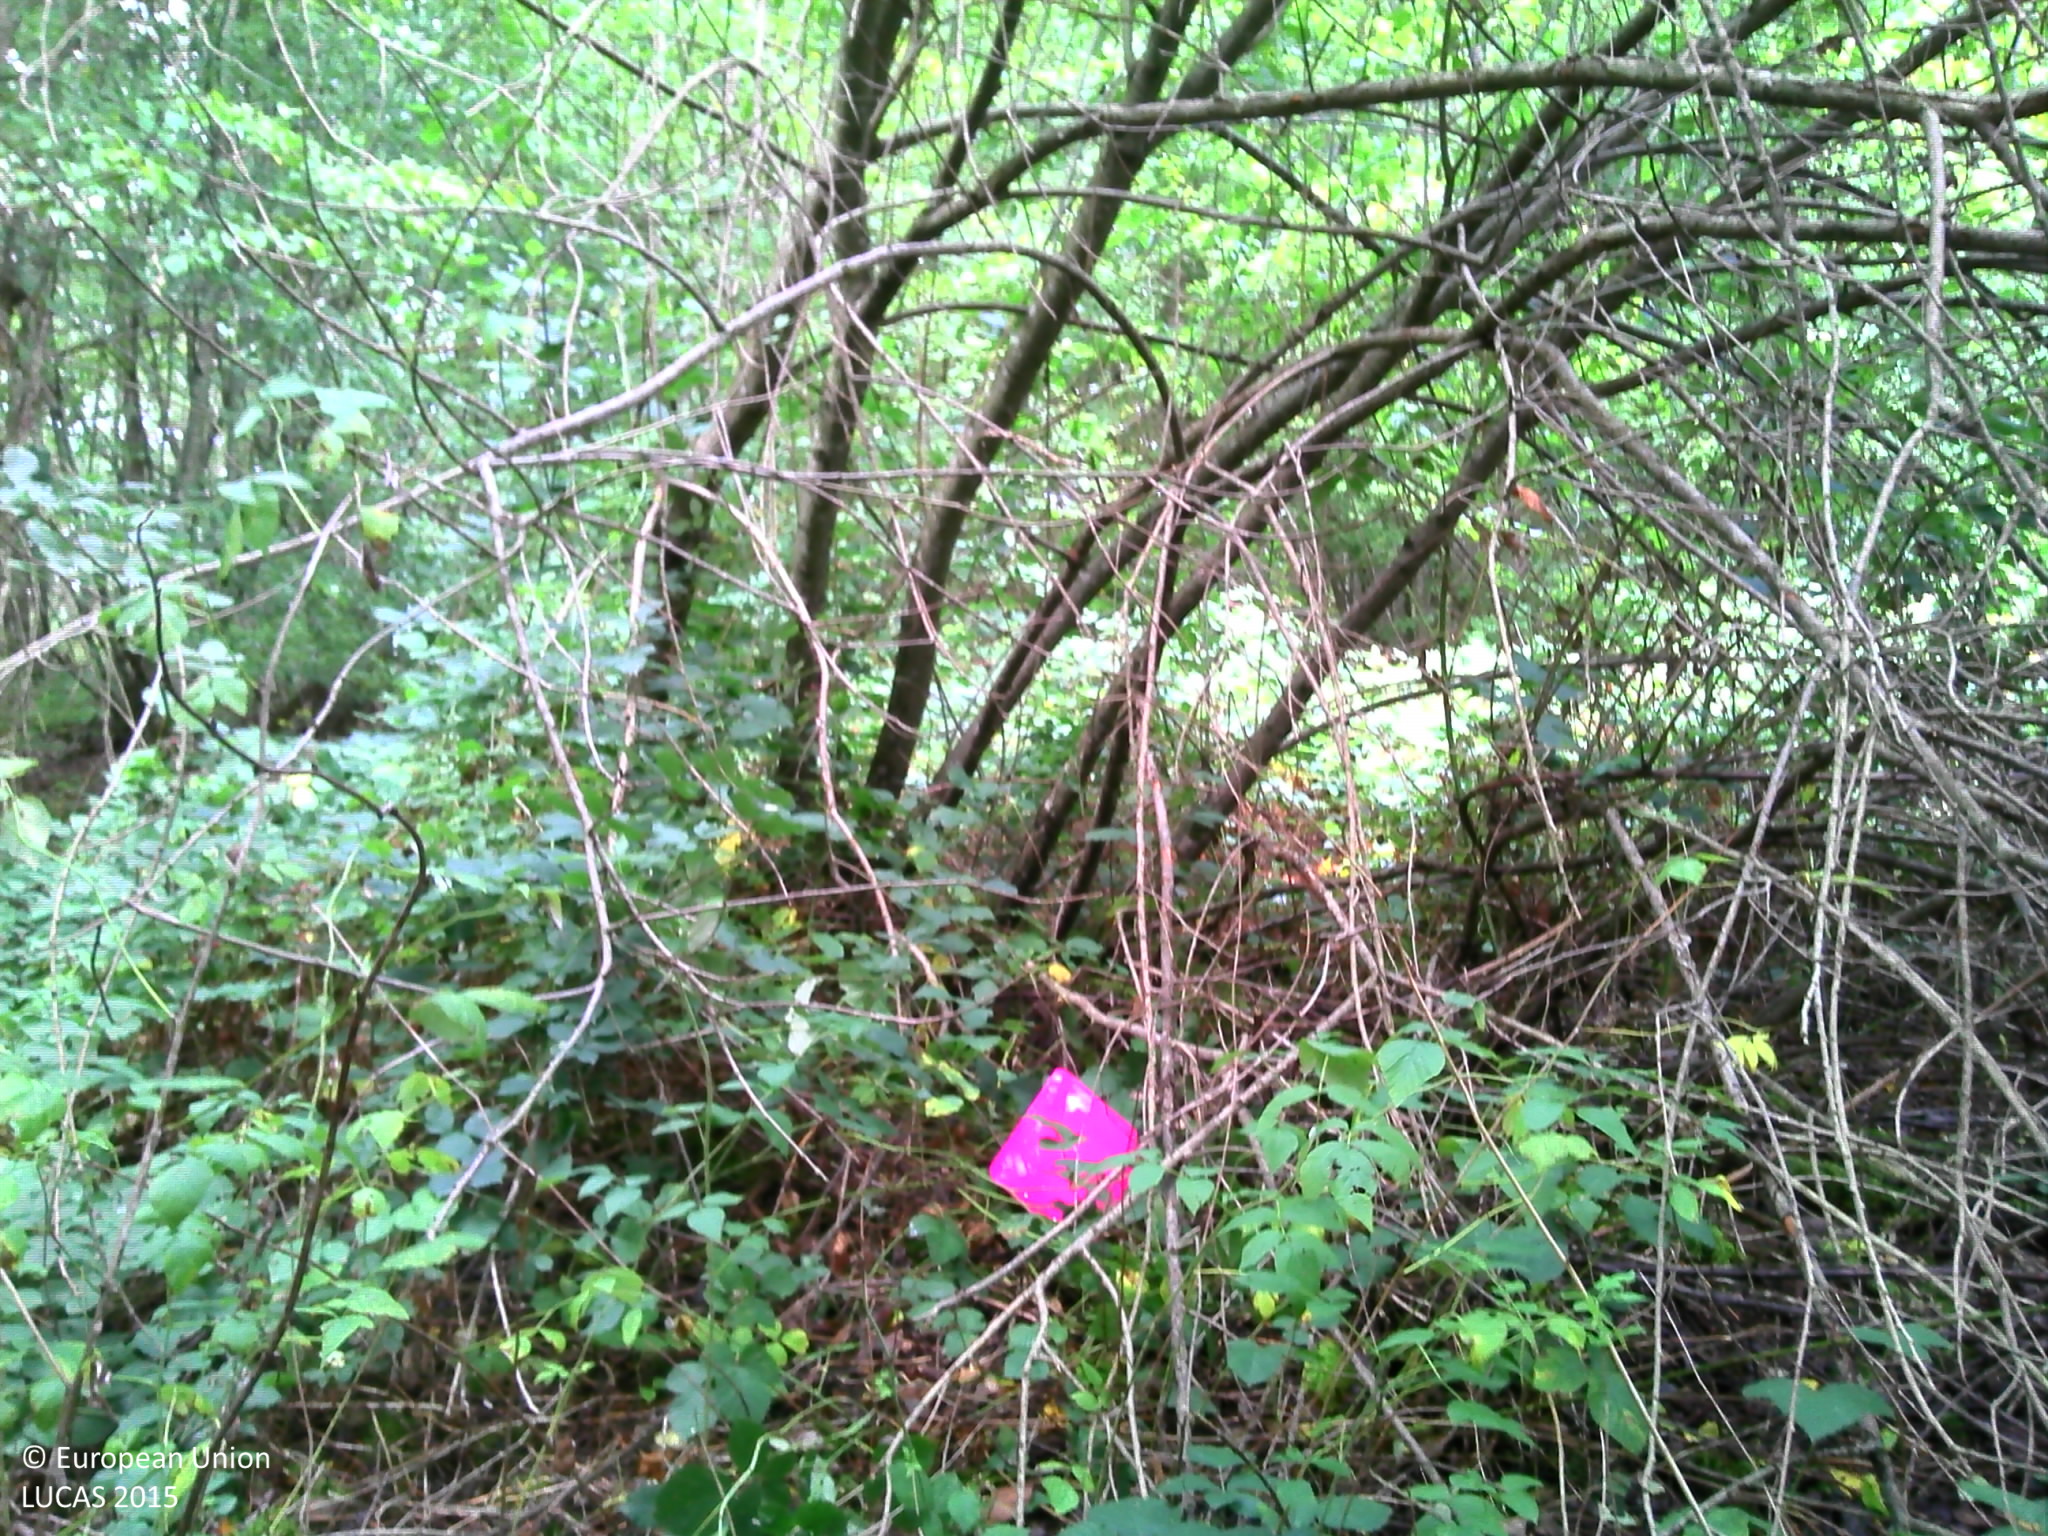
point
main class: Woodland
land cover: Broadleaved woodland
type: mesophytic deciduous forest
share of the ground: > 75 %
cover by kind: broadleaved forest trees 85 %, shrubs 15 %
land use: Forestry
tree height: > 5 m
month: September
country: FR
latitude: 47.3016
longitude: 4.3253
